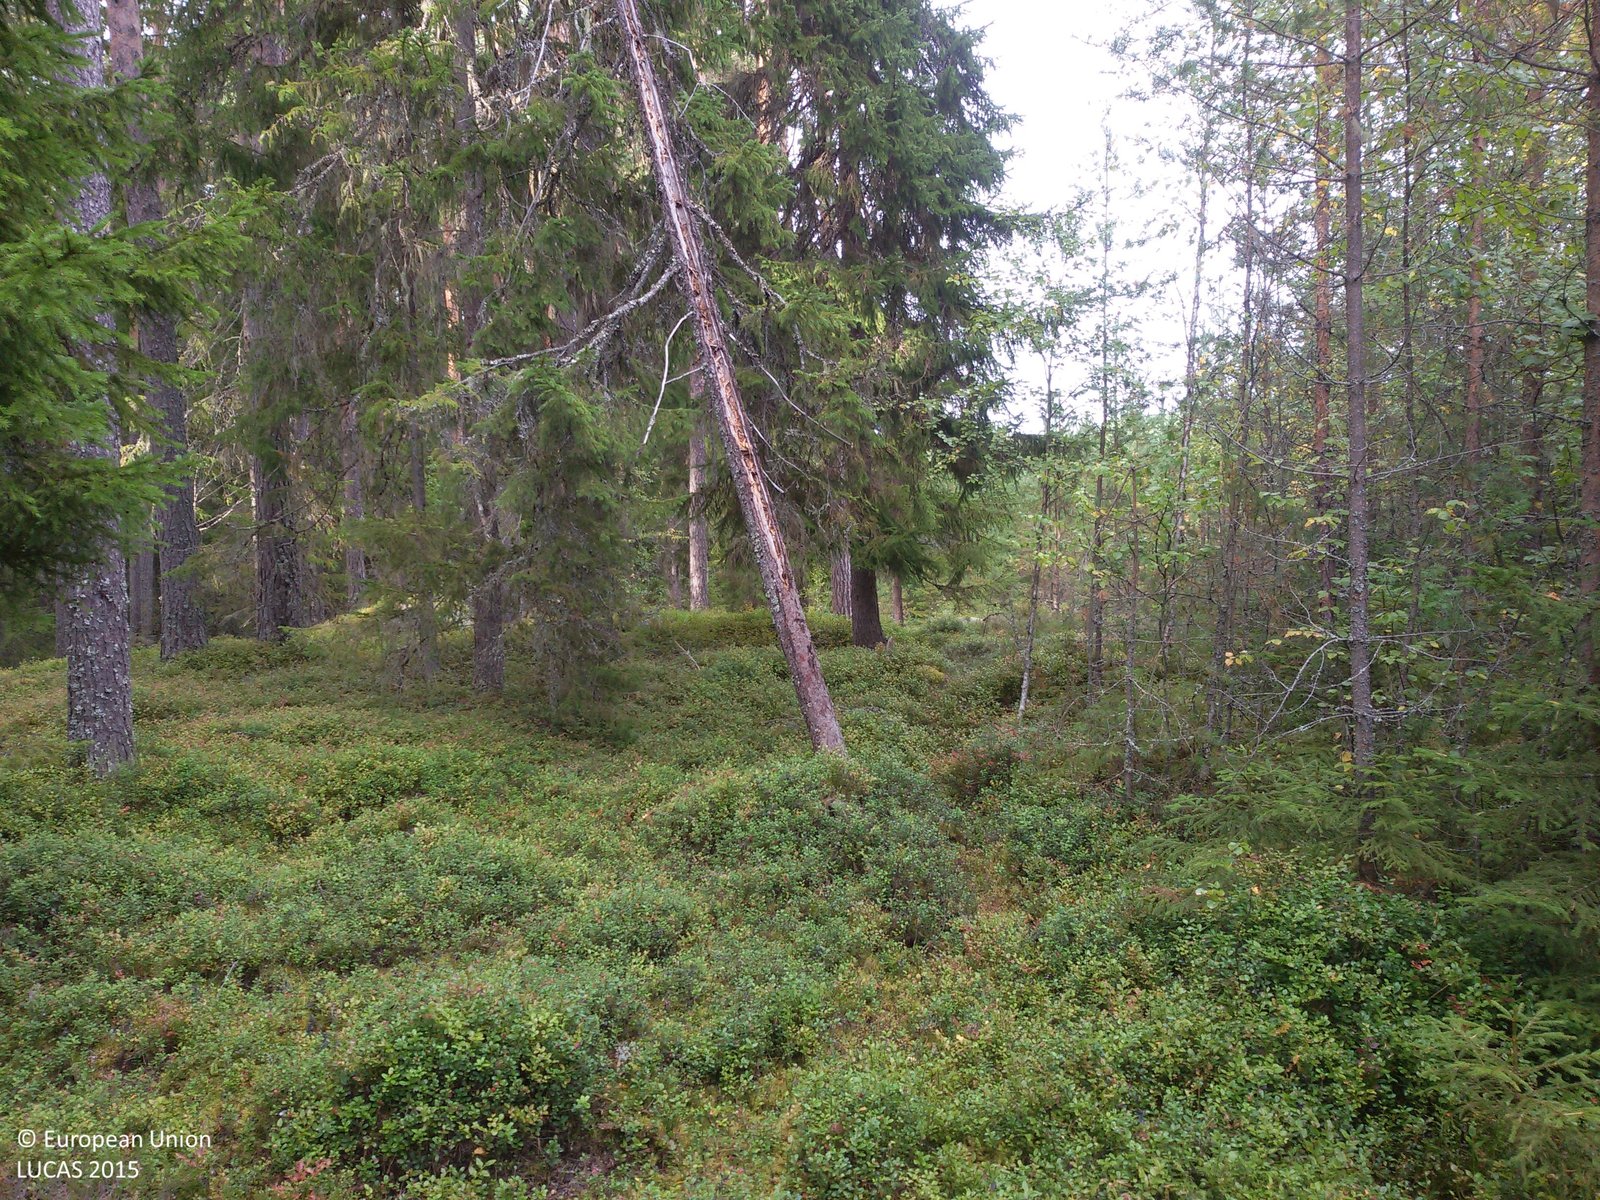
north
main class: Woodland
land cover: Pine dominated coniferous woodland
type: boreal forest
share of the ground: 50 - 75 %
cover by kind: coniferous forest trees 60 %, shrubs 20 %, broadleaved forest trees 10 %, herbaceous plants 5 %, lichens and mosses 5 %
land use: Forestry
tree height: > 5 m
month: September
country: SE
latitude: 60.7287
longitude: 15.3590
